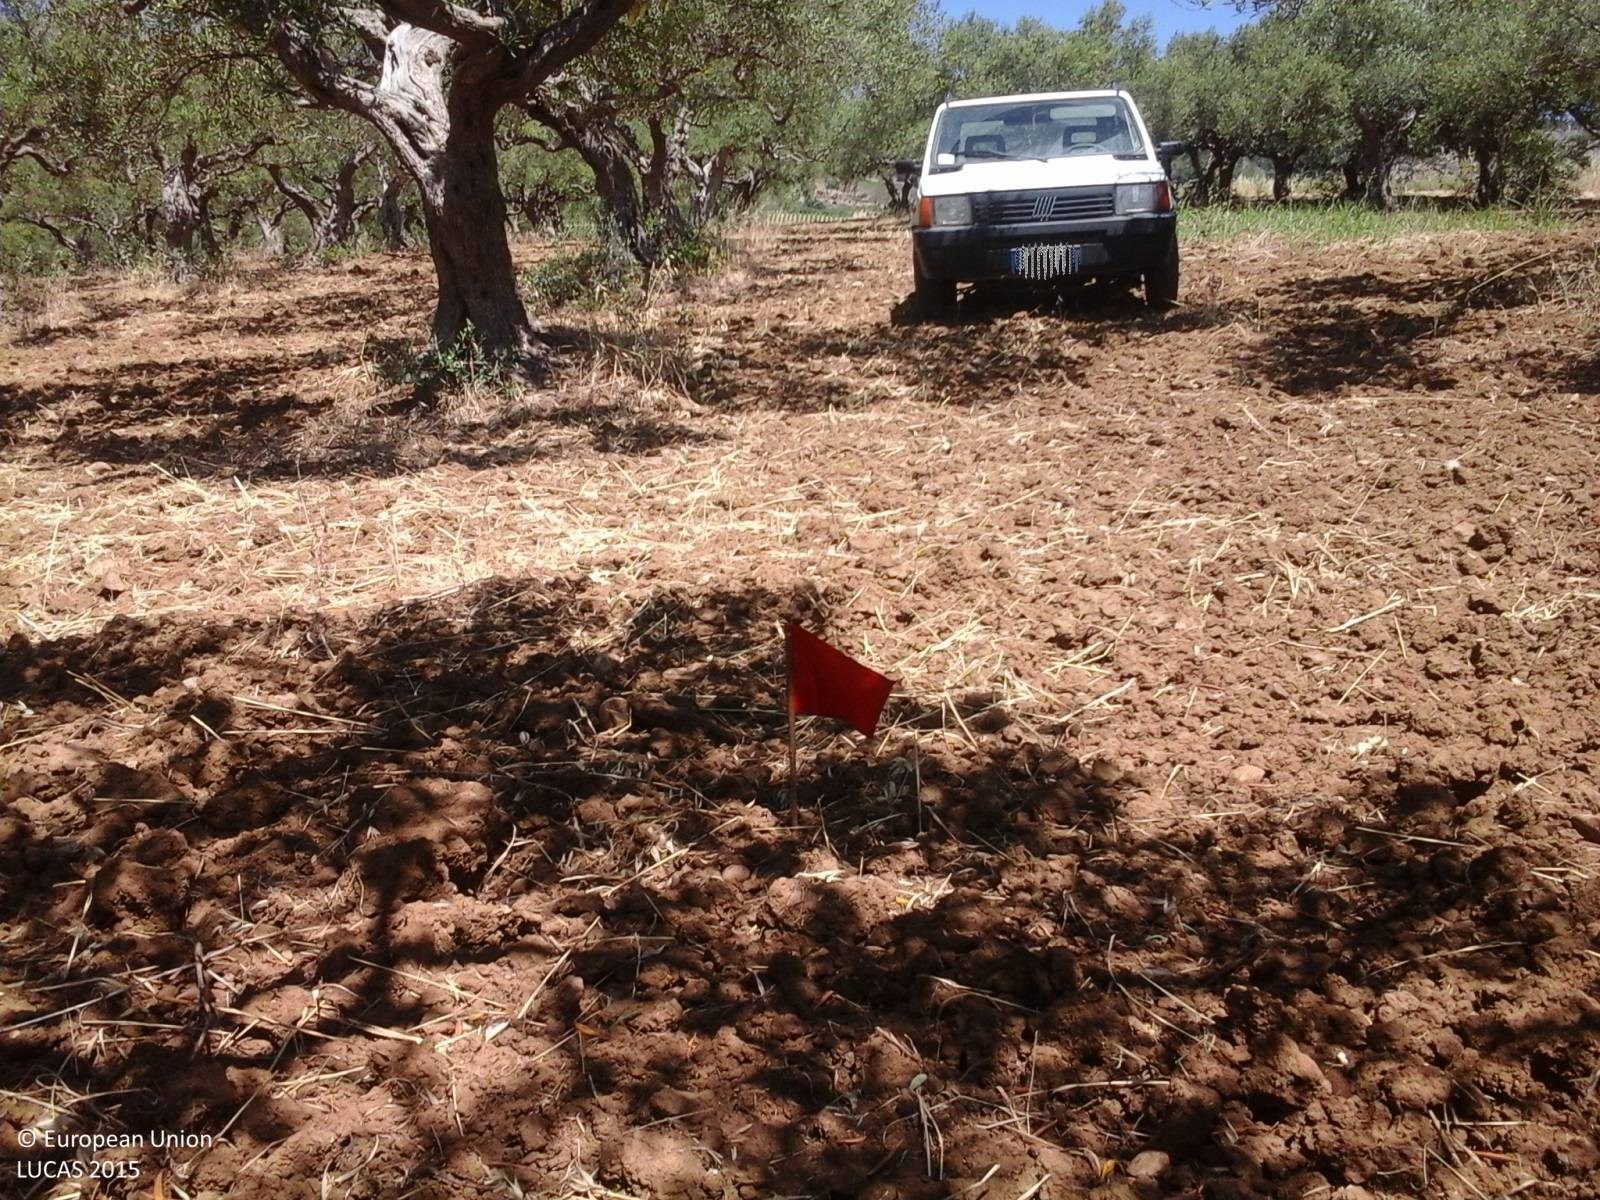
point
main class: Cropland
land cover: Olive groves
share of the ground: 50 - 75 %
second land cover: Other bare soil
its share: > 75 %
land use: Agriculture (excluding fallow land and kitchen gardens)
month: June
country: IT
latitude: 37.8500
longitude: 12.8543
